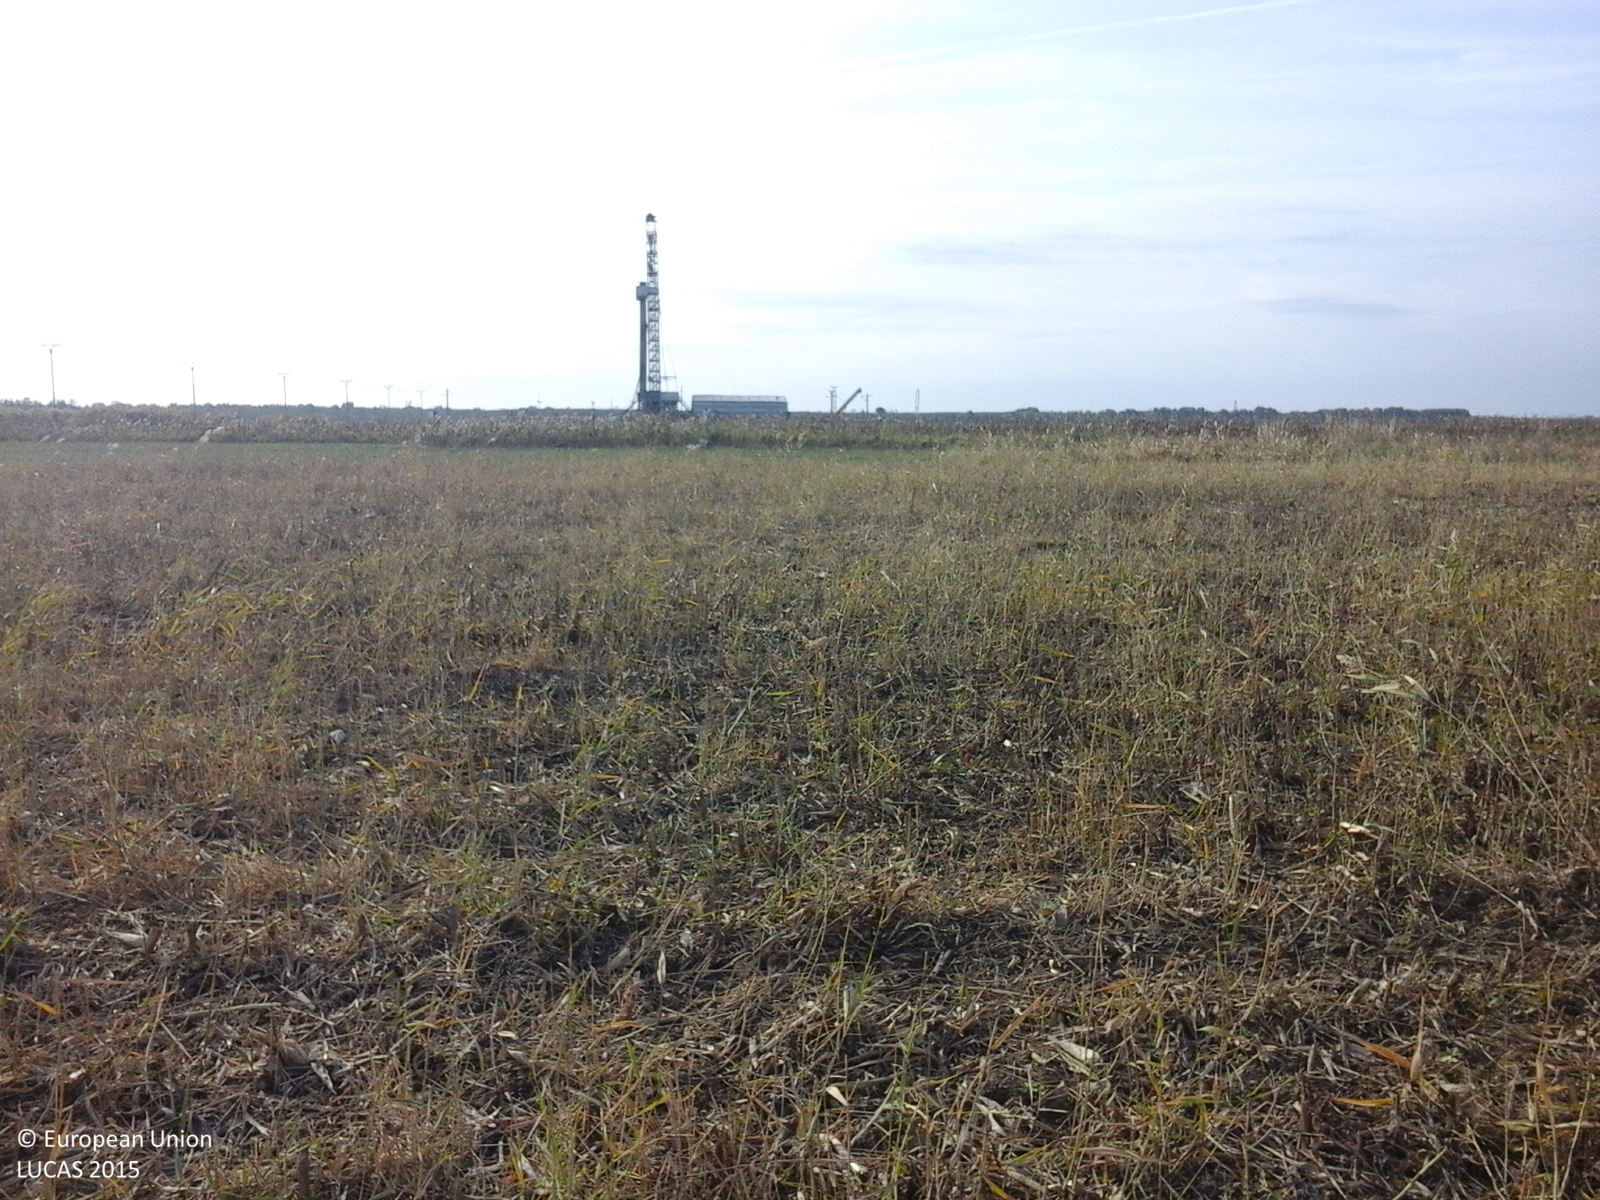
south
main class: Cropland
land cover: Maize
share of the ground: < 10 %
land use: Agriculture (excluding fallow land and kitchen gardens)
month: October
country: RO
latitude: 45.1257
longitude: 27.2160
